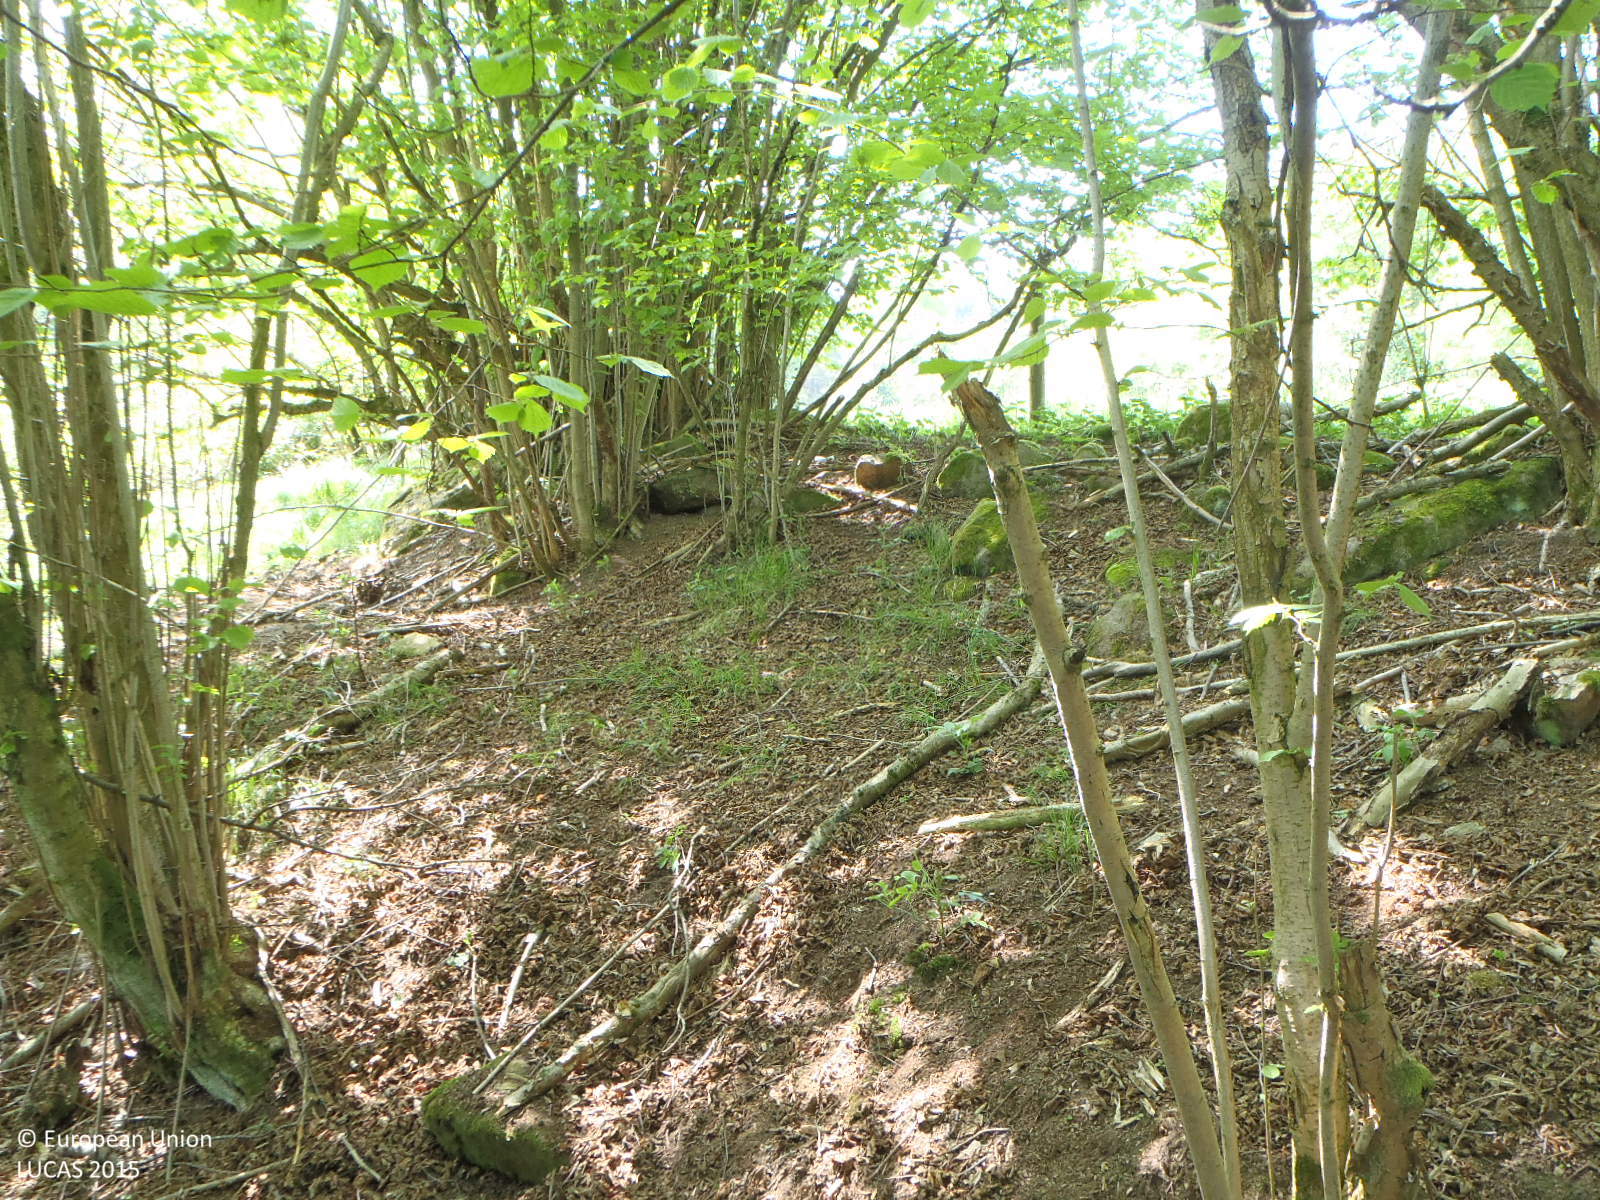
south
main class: Woodland
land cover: Broadleaved woodland
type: mesophytic deciduous forest
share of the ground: > 75 %
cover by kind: broadleaved forest trees 90 %, lichens and mosses 5 %, unconsolidated bare surface 5 %
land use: Semi-natural and natural areas not in use
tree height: > 5 m
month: May
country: CZ
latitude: 49.0452
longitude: 15.0506
